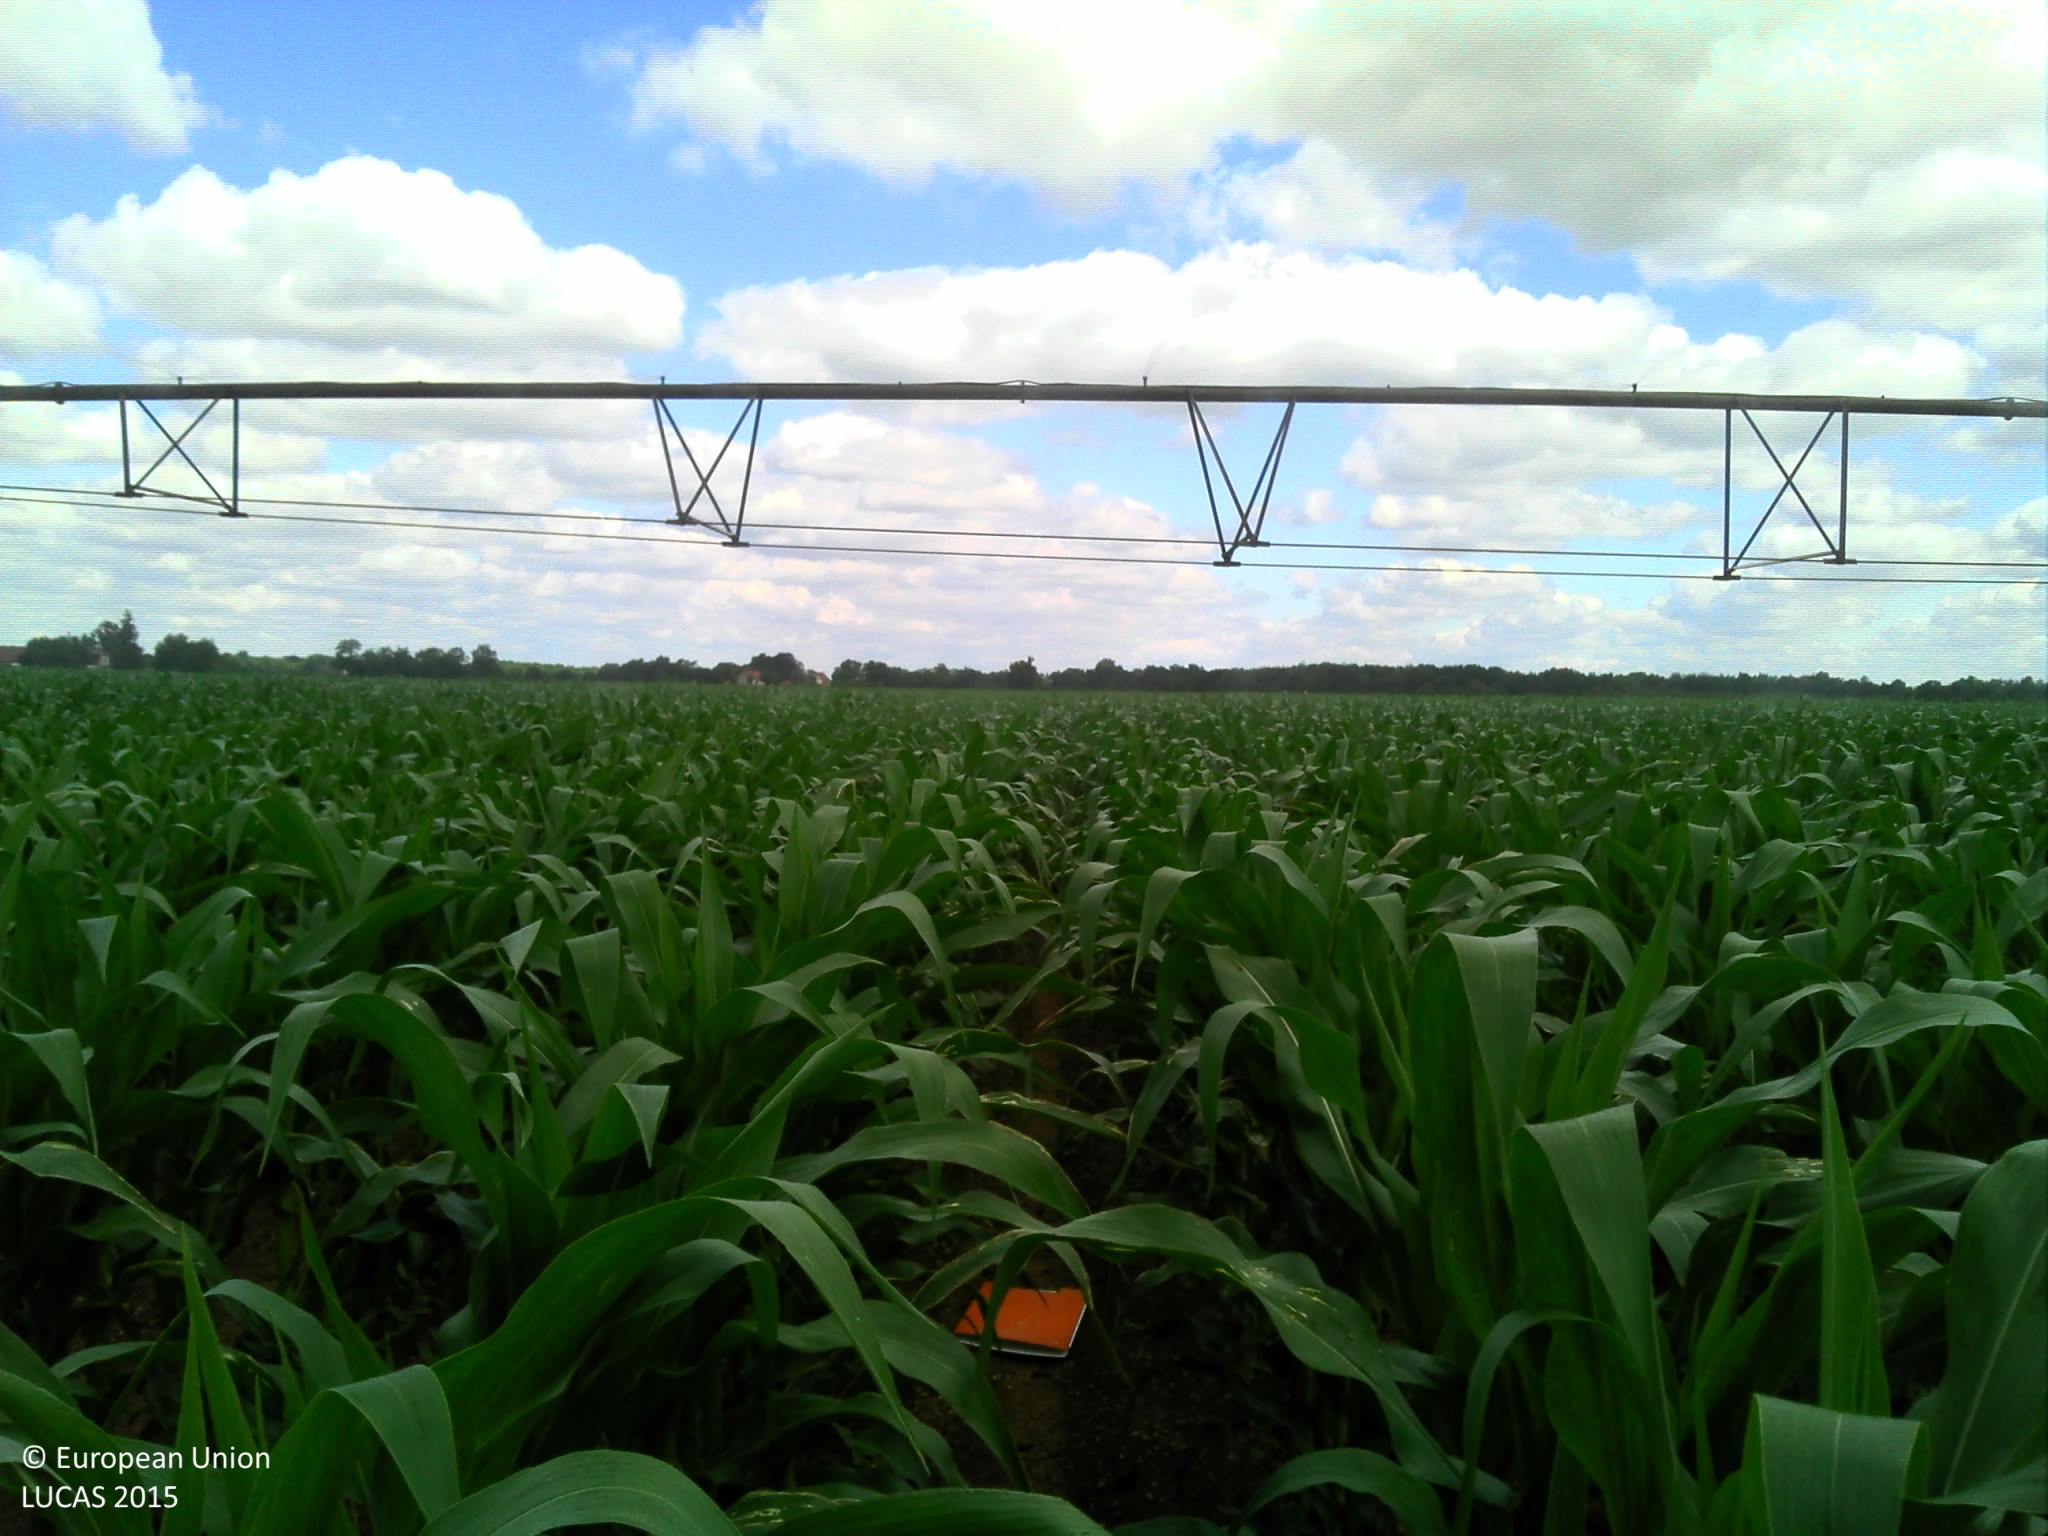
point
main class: Cropland
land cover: Maize
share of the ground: > 75 %
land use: Agriculture (excluding fallow land and kitchen gardens)
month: June
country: FR
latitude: 46.7032
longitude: 3.6292
